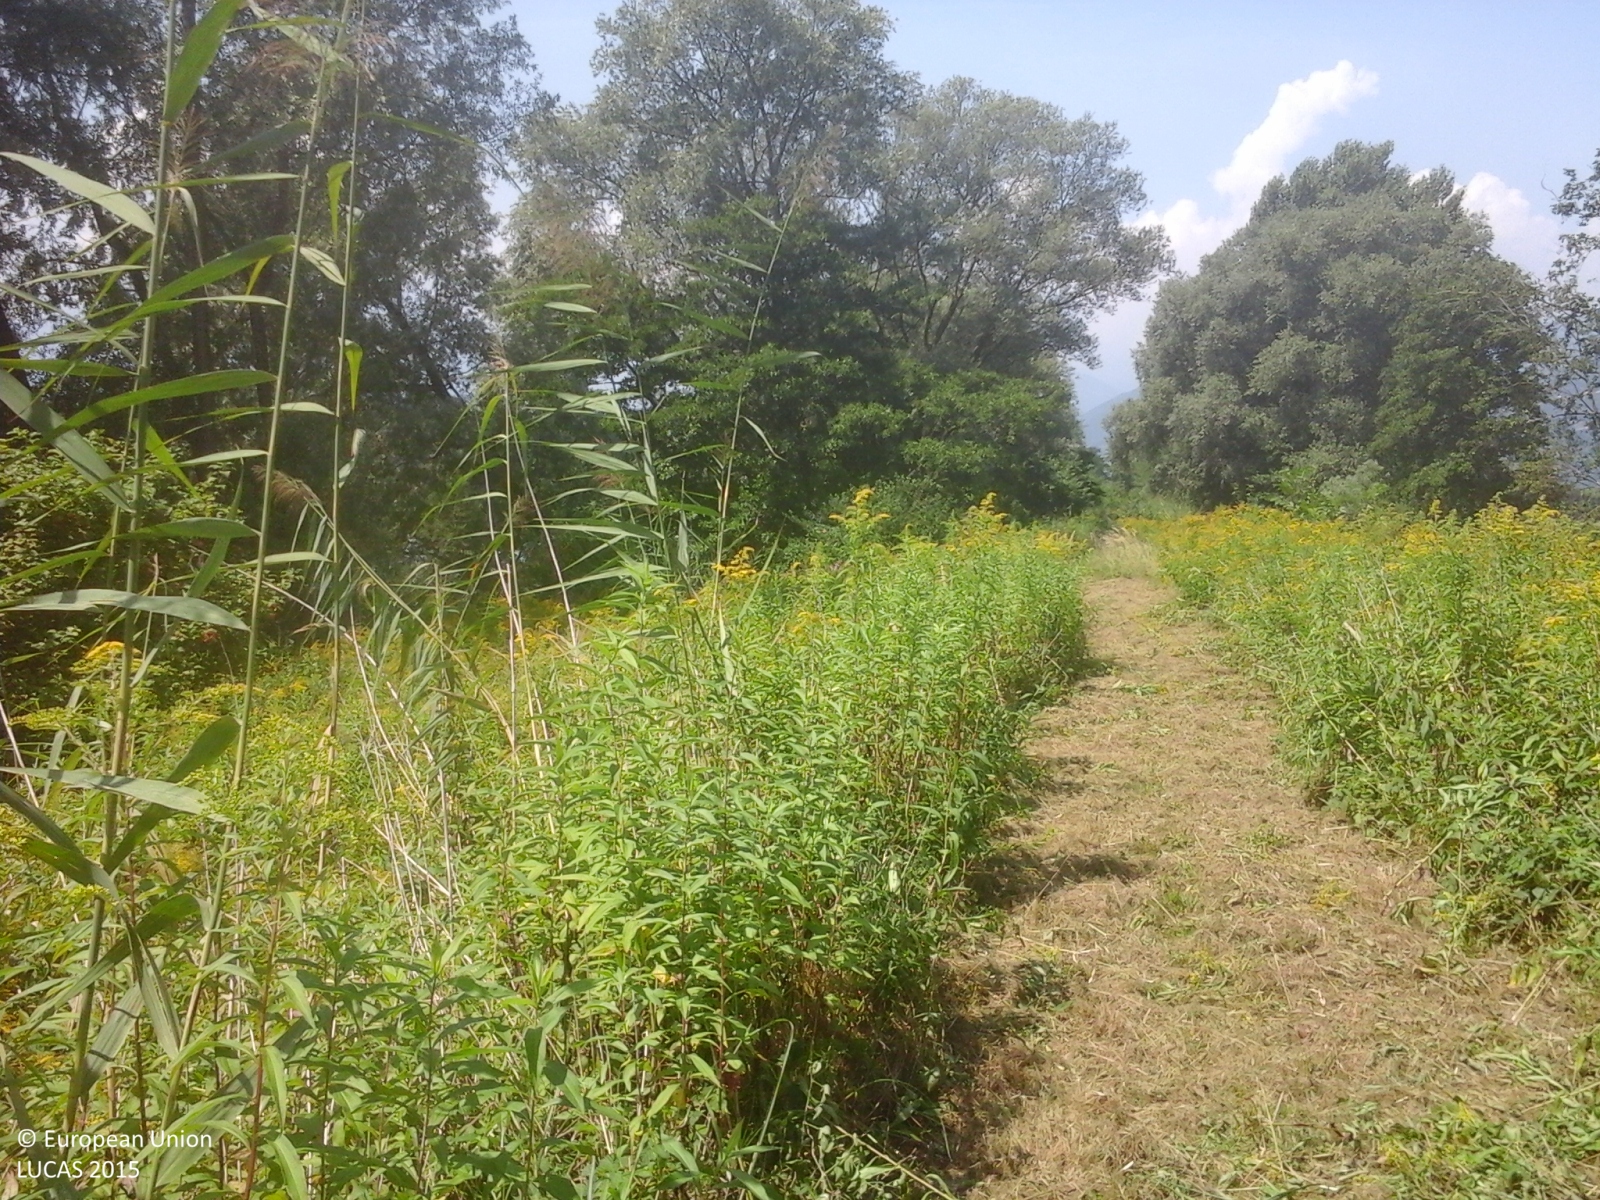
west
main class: Woodland
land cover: Broadleaved woodland
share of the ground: > 75 %
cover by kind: broadleaved forest trees 90 %, shrubs 5 %, herbaceous plants 5 %
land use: Semi-natural and natural areas not in use
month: August
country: IT
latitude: 46.1513
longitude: 9.3923
